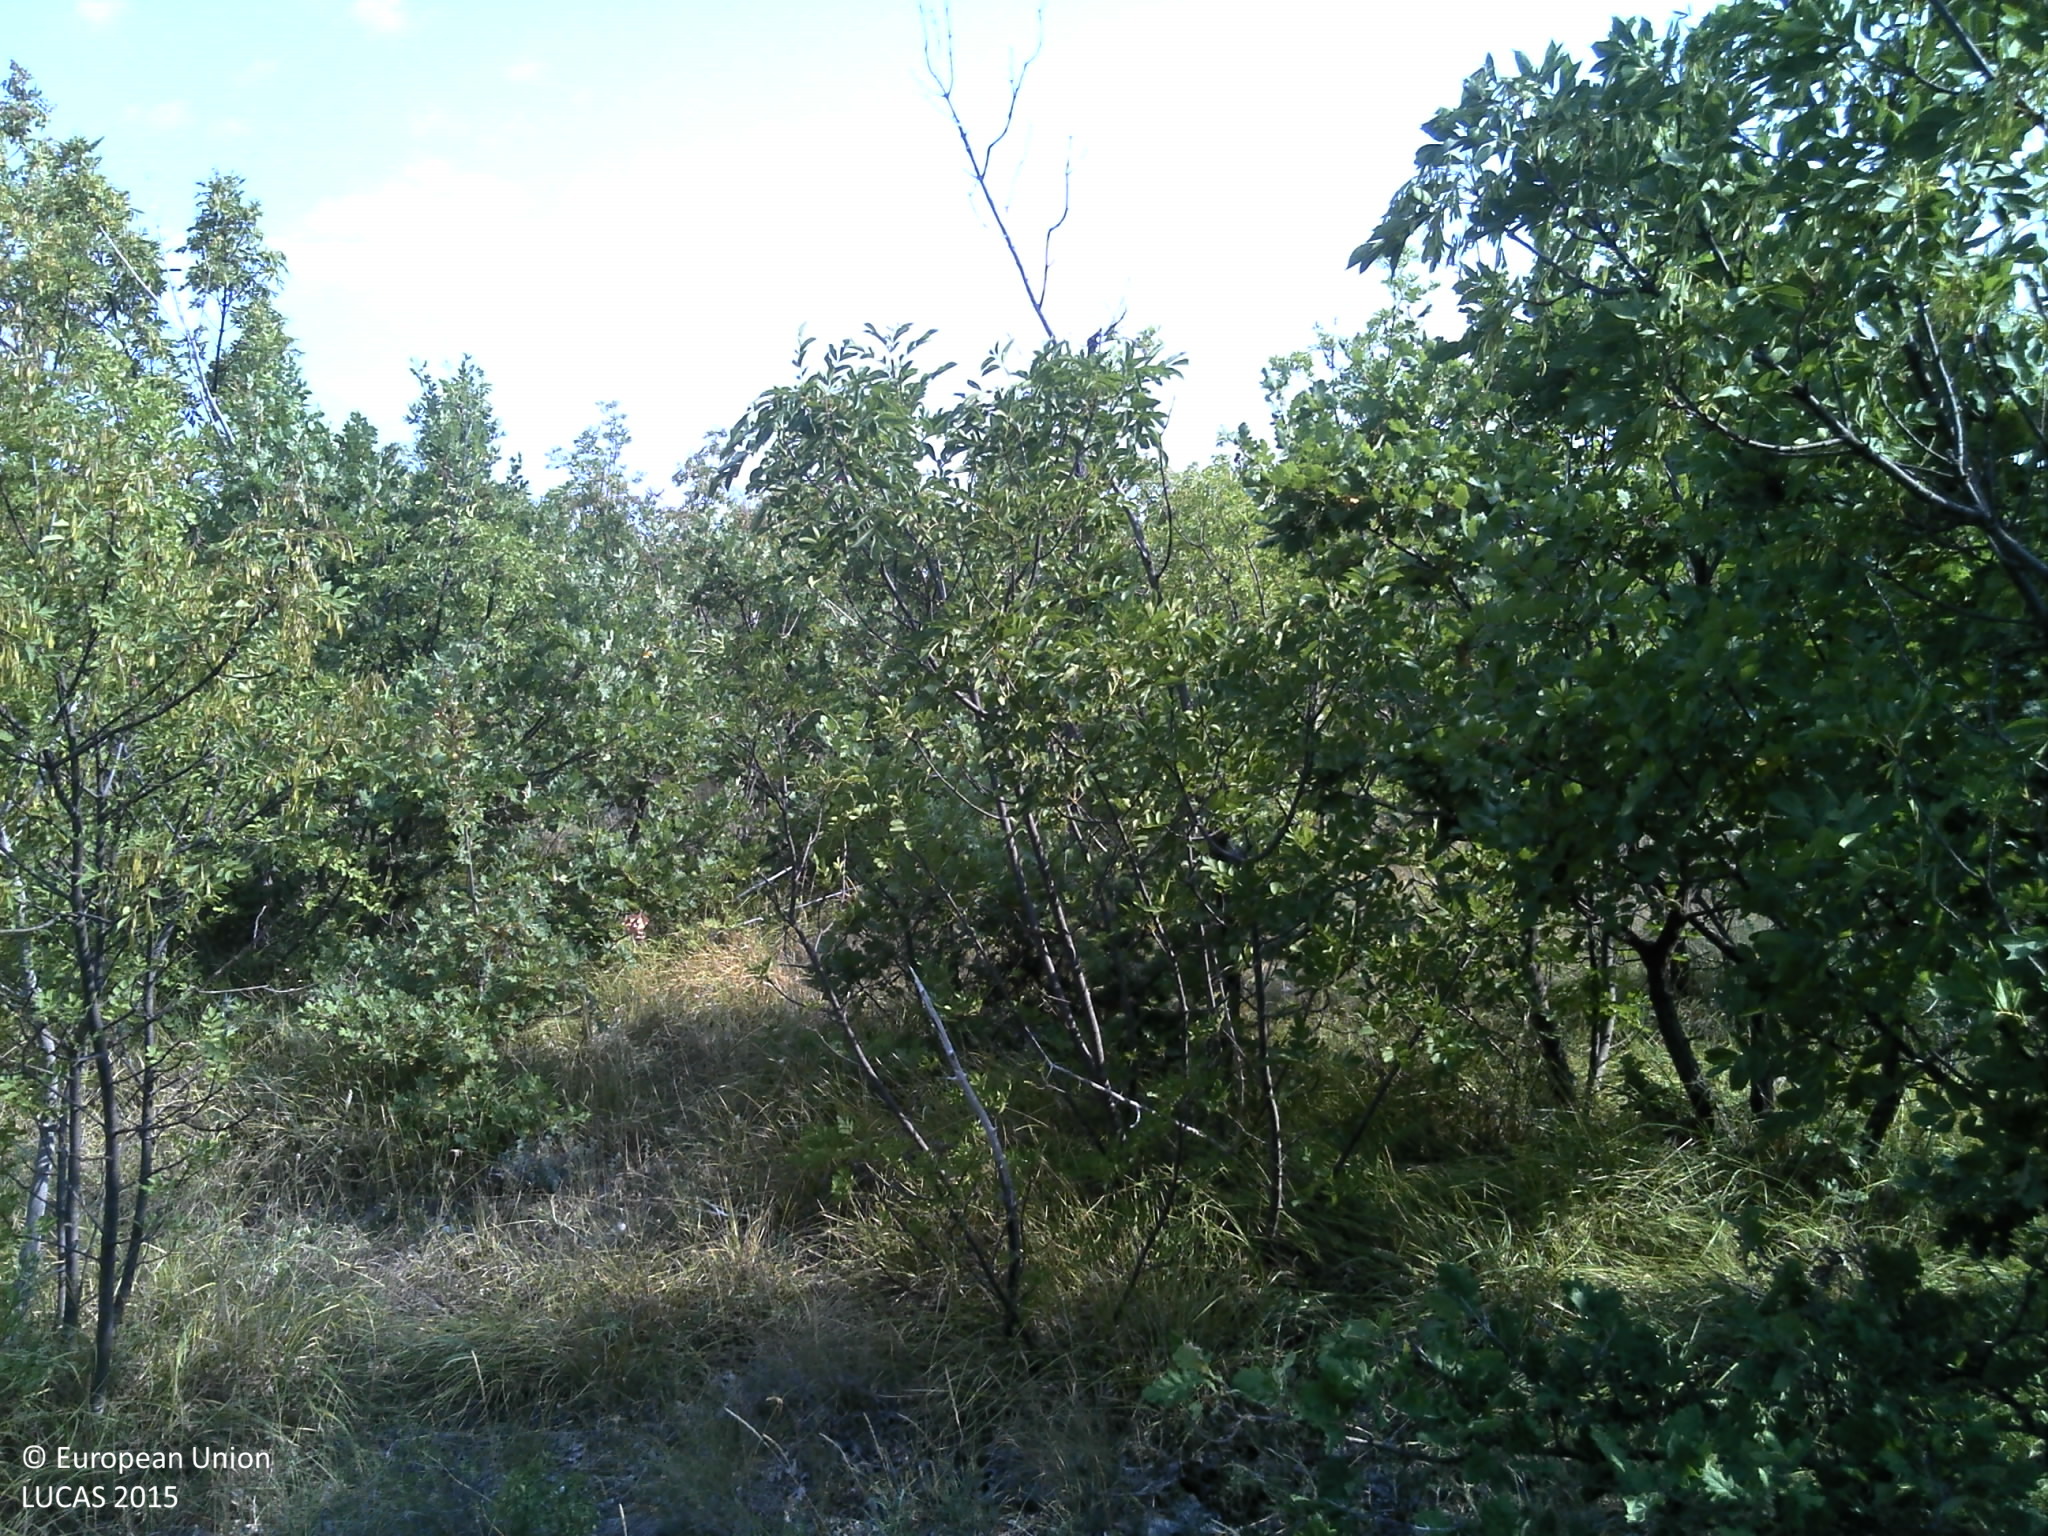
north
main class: Shrubland
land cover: Shrubland with sparse tree cover
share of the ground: > 75 %
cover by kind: shrubs 70 %, herbaceous plants 15 %, broadleaved forest trees 5 %, lichens and mosses 5 %, consolidated bare surface 5 %
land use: Semi-natural and natural areas not in use
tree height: > 5 m
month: July
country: HR
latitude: 43.4657
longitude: 16.9504
